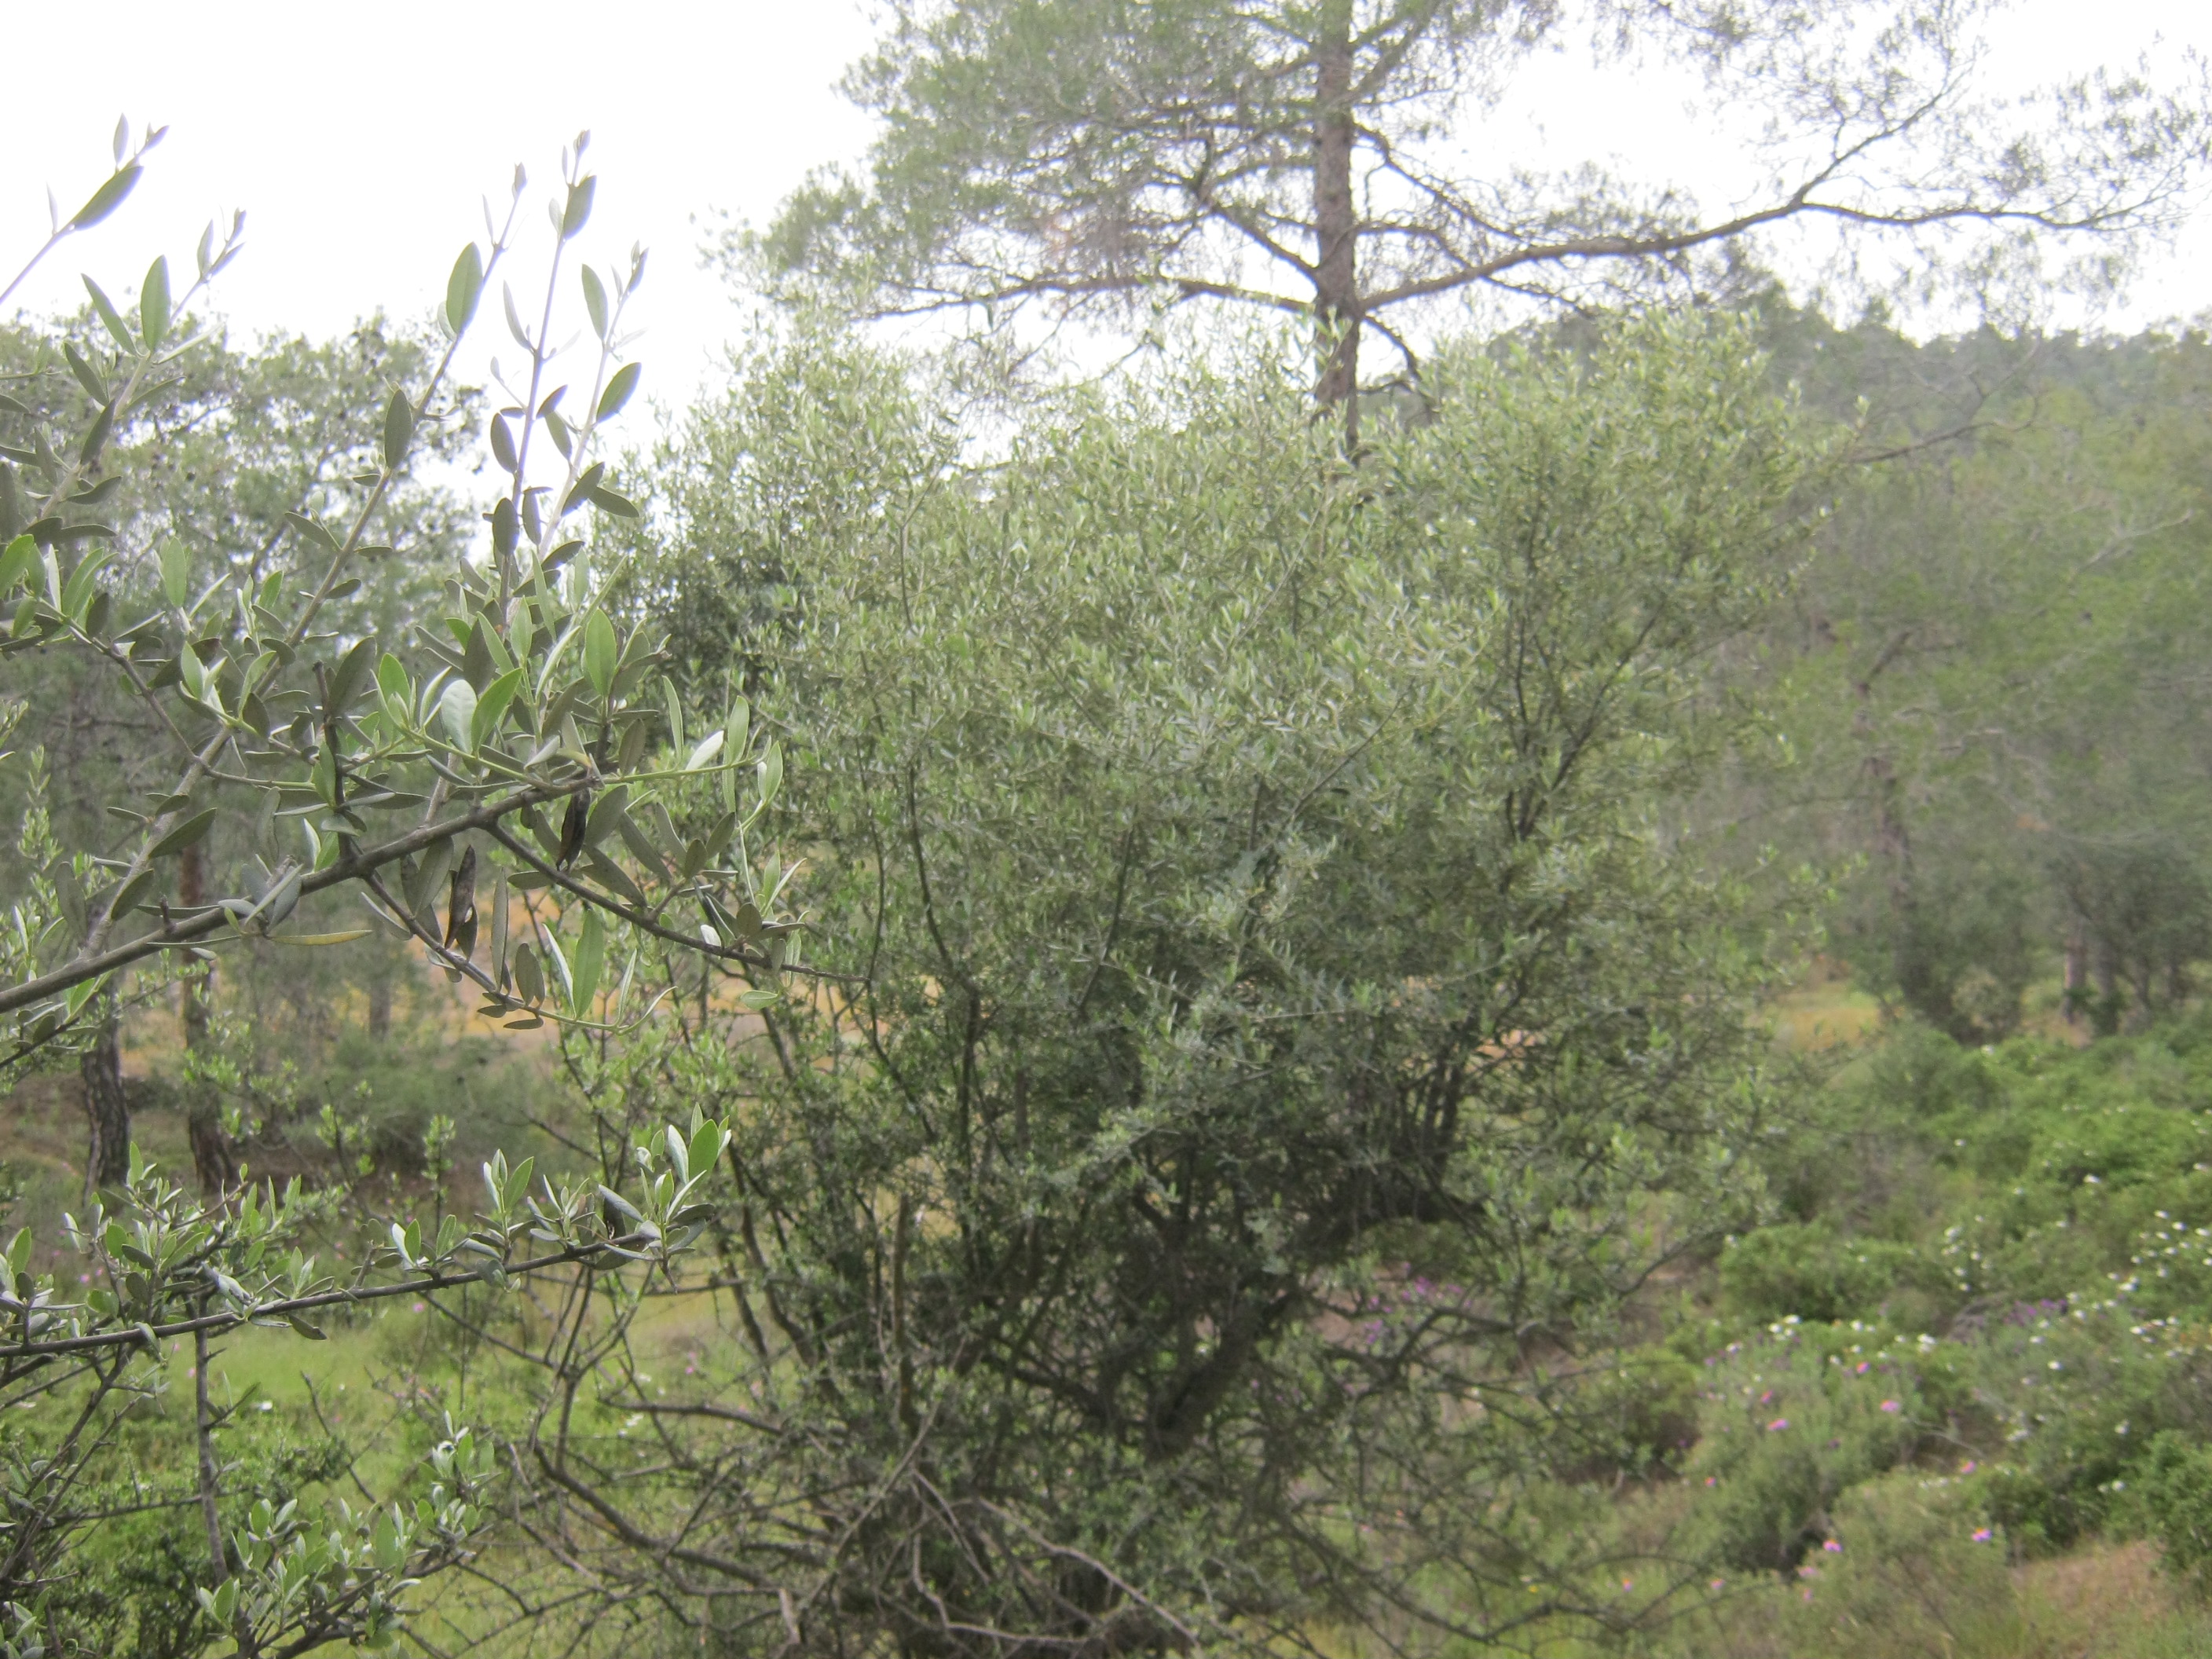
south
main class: Woodland
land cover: Pine dominated coniferous woodland
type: coniferous forest of the mediterranean region
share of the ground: 50 - 75 %
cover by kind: coniferous forest trees 60 %, shrubs 20 %, herbaceous plants 20 %
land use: Semi-natural and natural areas not in use
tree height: > 5 m
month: April
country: CY
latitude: 34.9372
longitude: 33.3183
